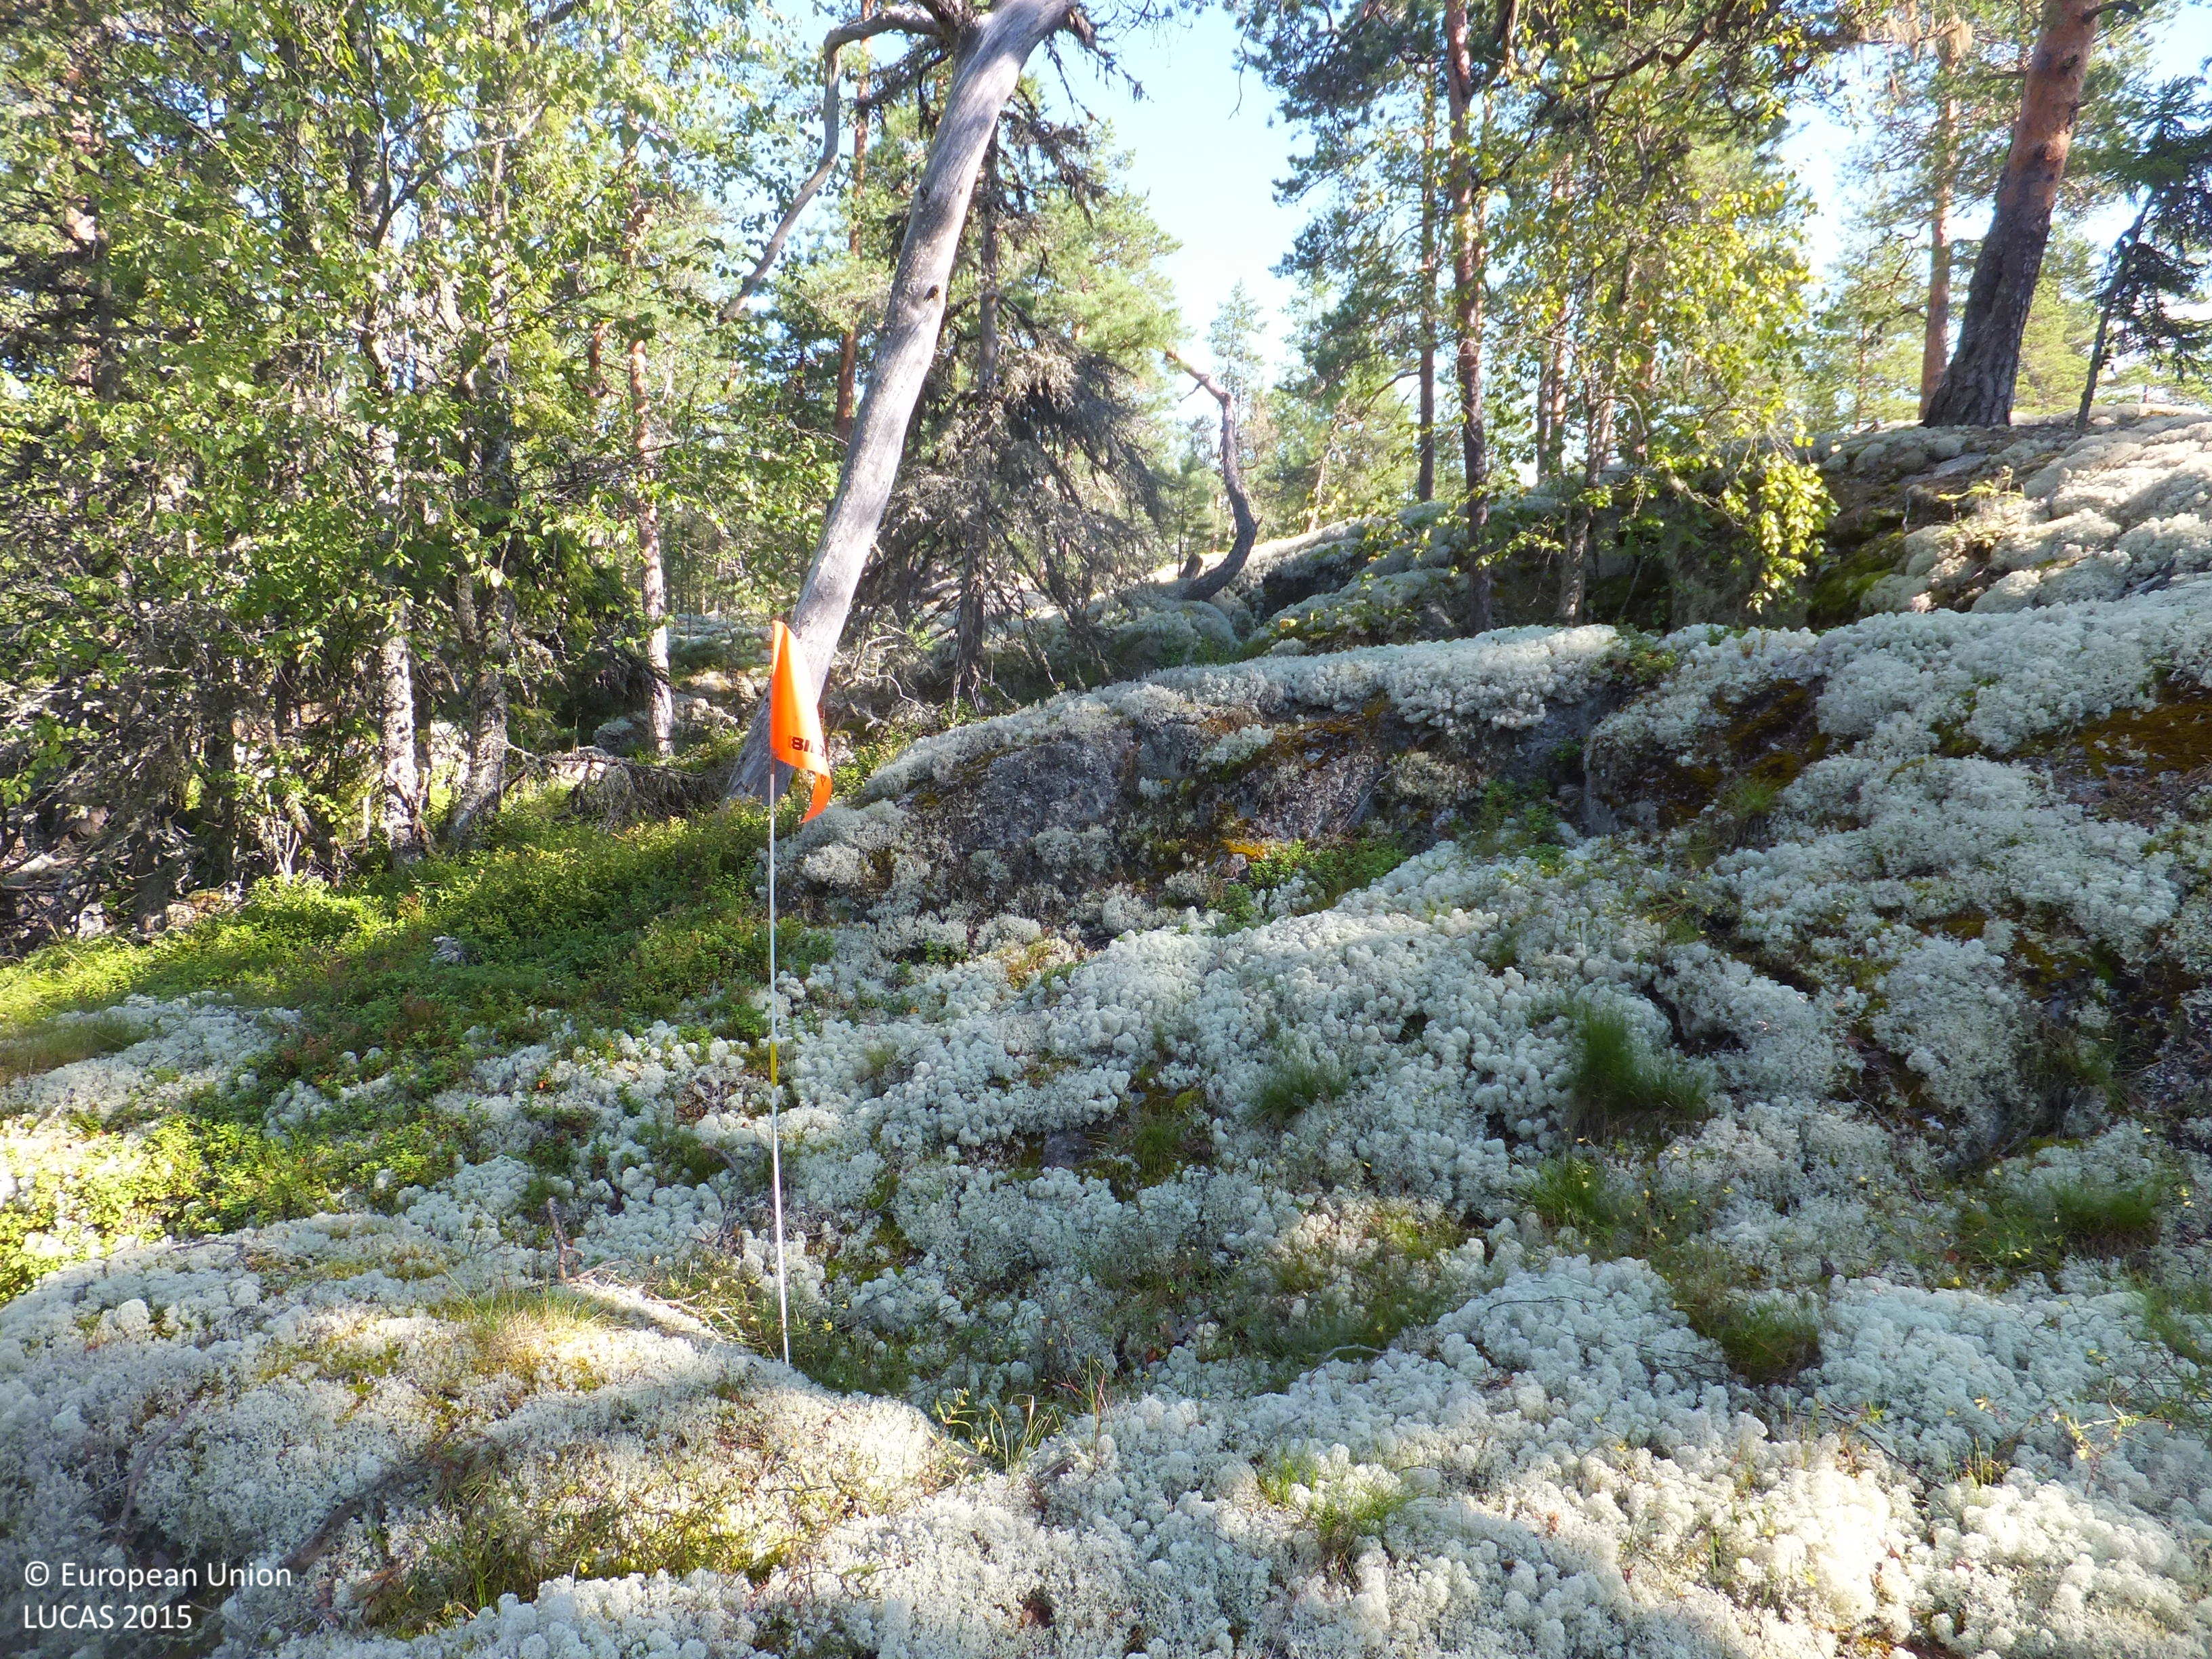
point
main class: Woodland
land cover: Pine dominated mixed woodland
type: boreal forest
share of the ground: 25 - 50 %
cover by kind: lichens and mosses 30 %, shrubs 25 %, coniferous forest trees 20 %, broadleaved forest trees 10 %, herbaceous plants 10 %, consolidated bare surface 5 %
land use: Forestry
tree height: > 5 m
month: August
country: FI
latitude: 63.1149
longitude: 22.0367
